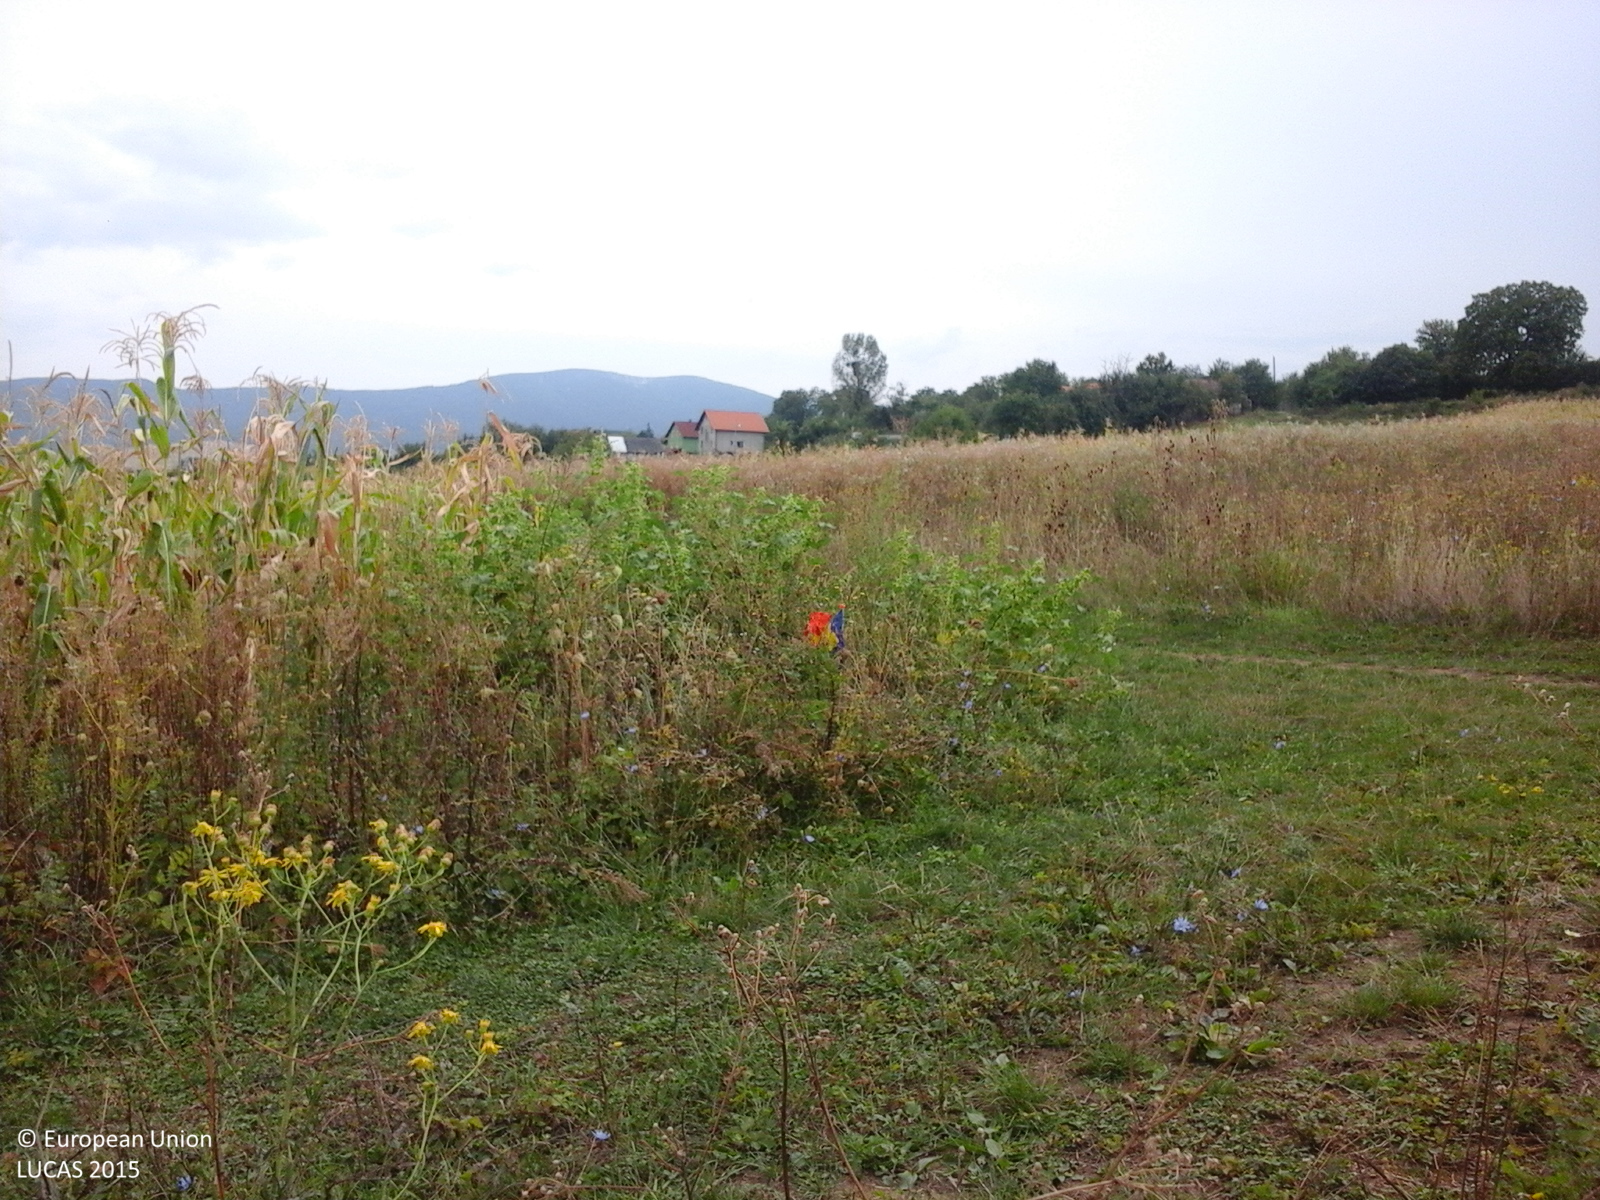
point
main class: Grassland
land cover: Spontaneously vegetated surfaces
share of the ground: > 75 %
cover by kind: herbaceous plants 100 %
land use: Fallow land
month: September
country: RO
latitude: 47.1756
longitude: 23.0070
